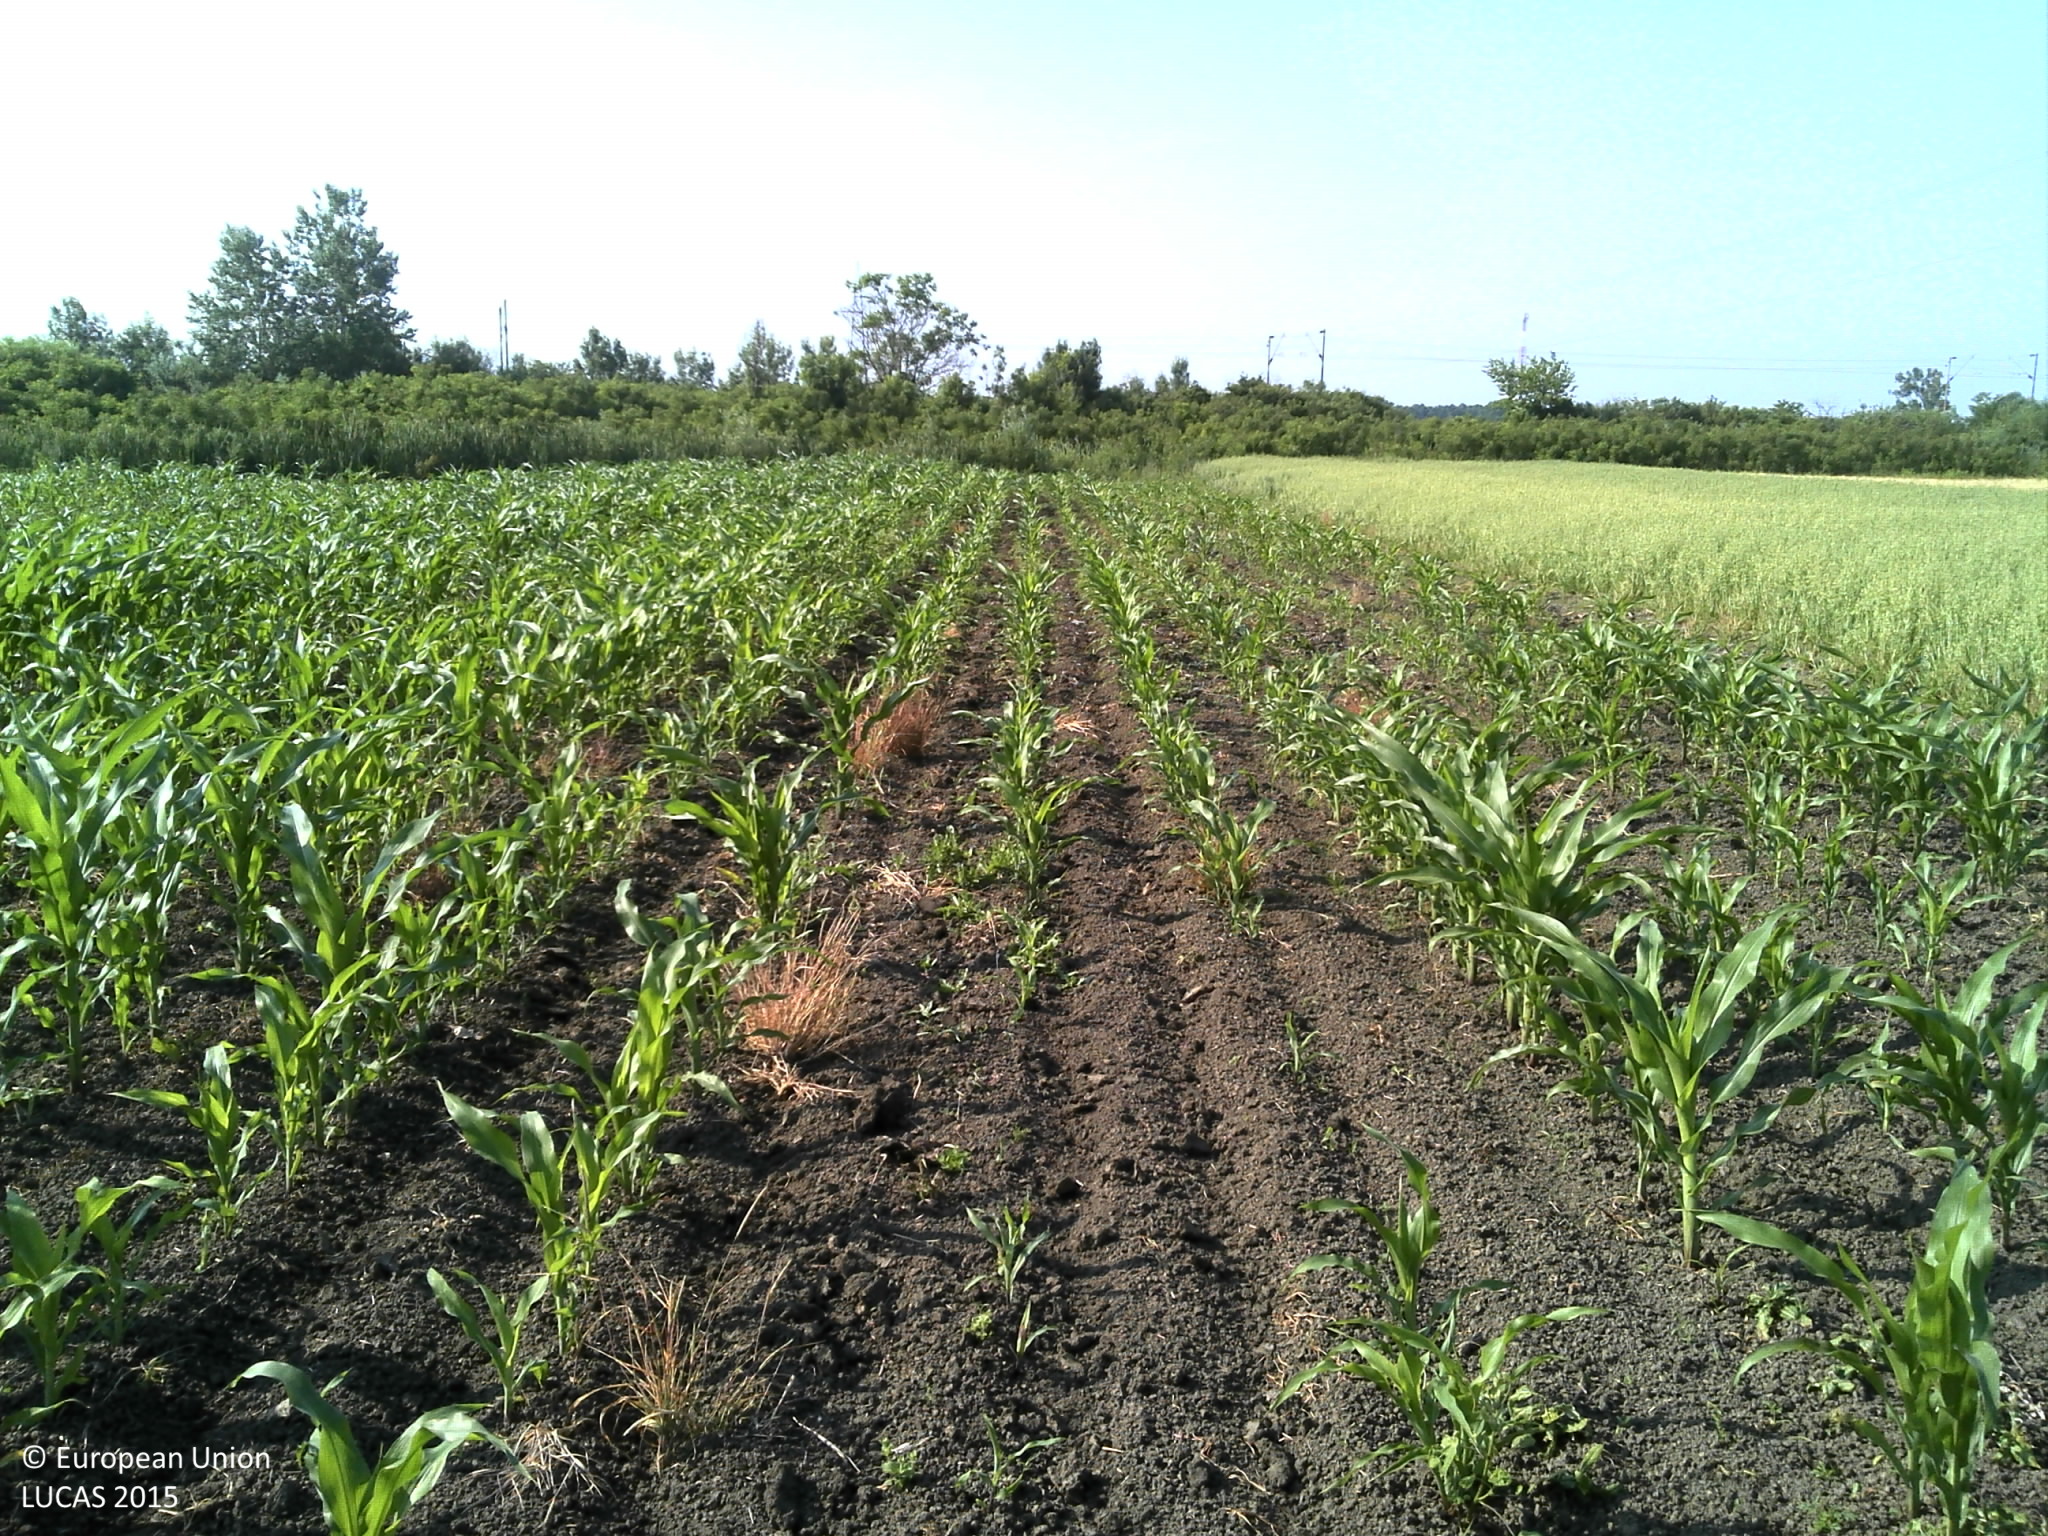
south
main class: Cropland
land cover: Maize
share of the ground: 25 - 50 %
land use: Agriculture (excluding fallow land and kitchen gardens)
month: June
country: HR
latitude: 45.2376
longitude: 18.4507
